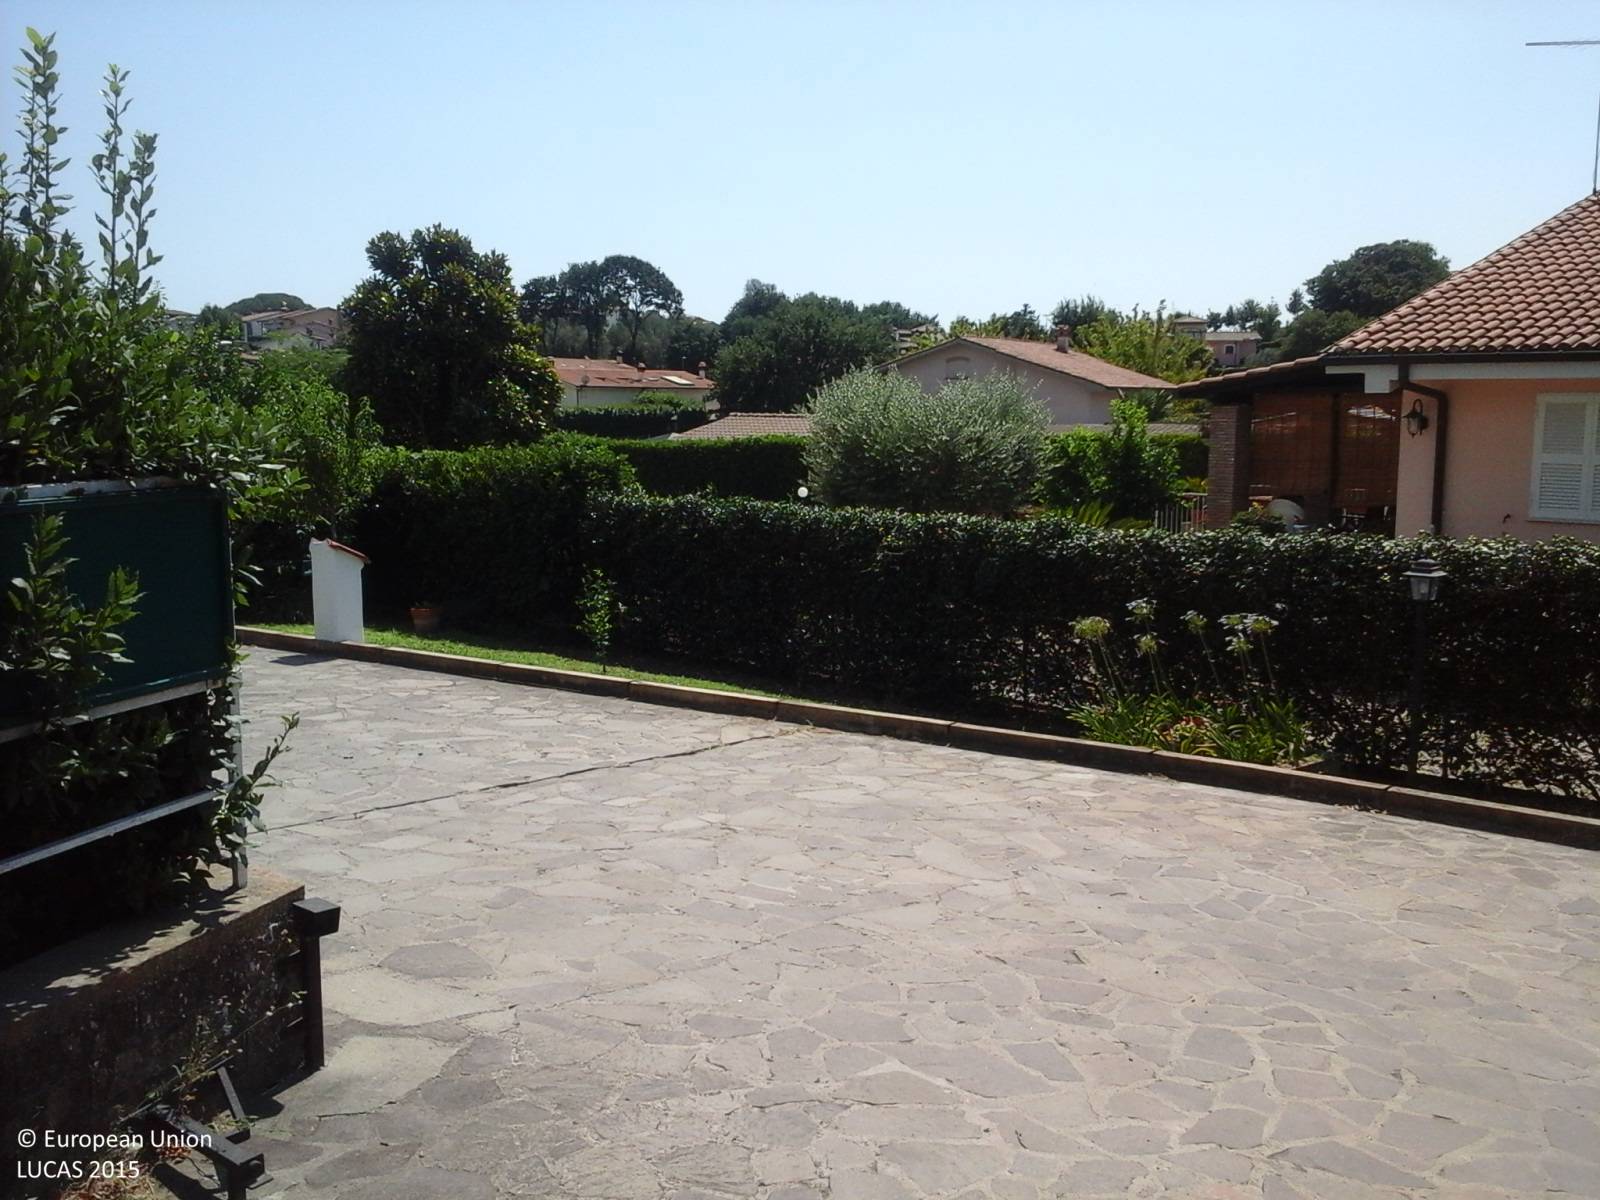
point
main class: Grassland
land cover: Grassland with sparse tree/shrub cover
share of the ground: > 75 %
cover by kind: herbaceous plants 90 %, broadleaved forest trees 5 %, shrubs 5 %
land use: Residential
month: August
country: IT
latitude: 42.0863
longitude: 12.2766
